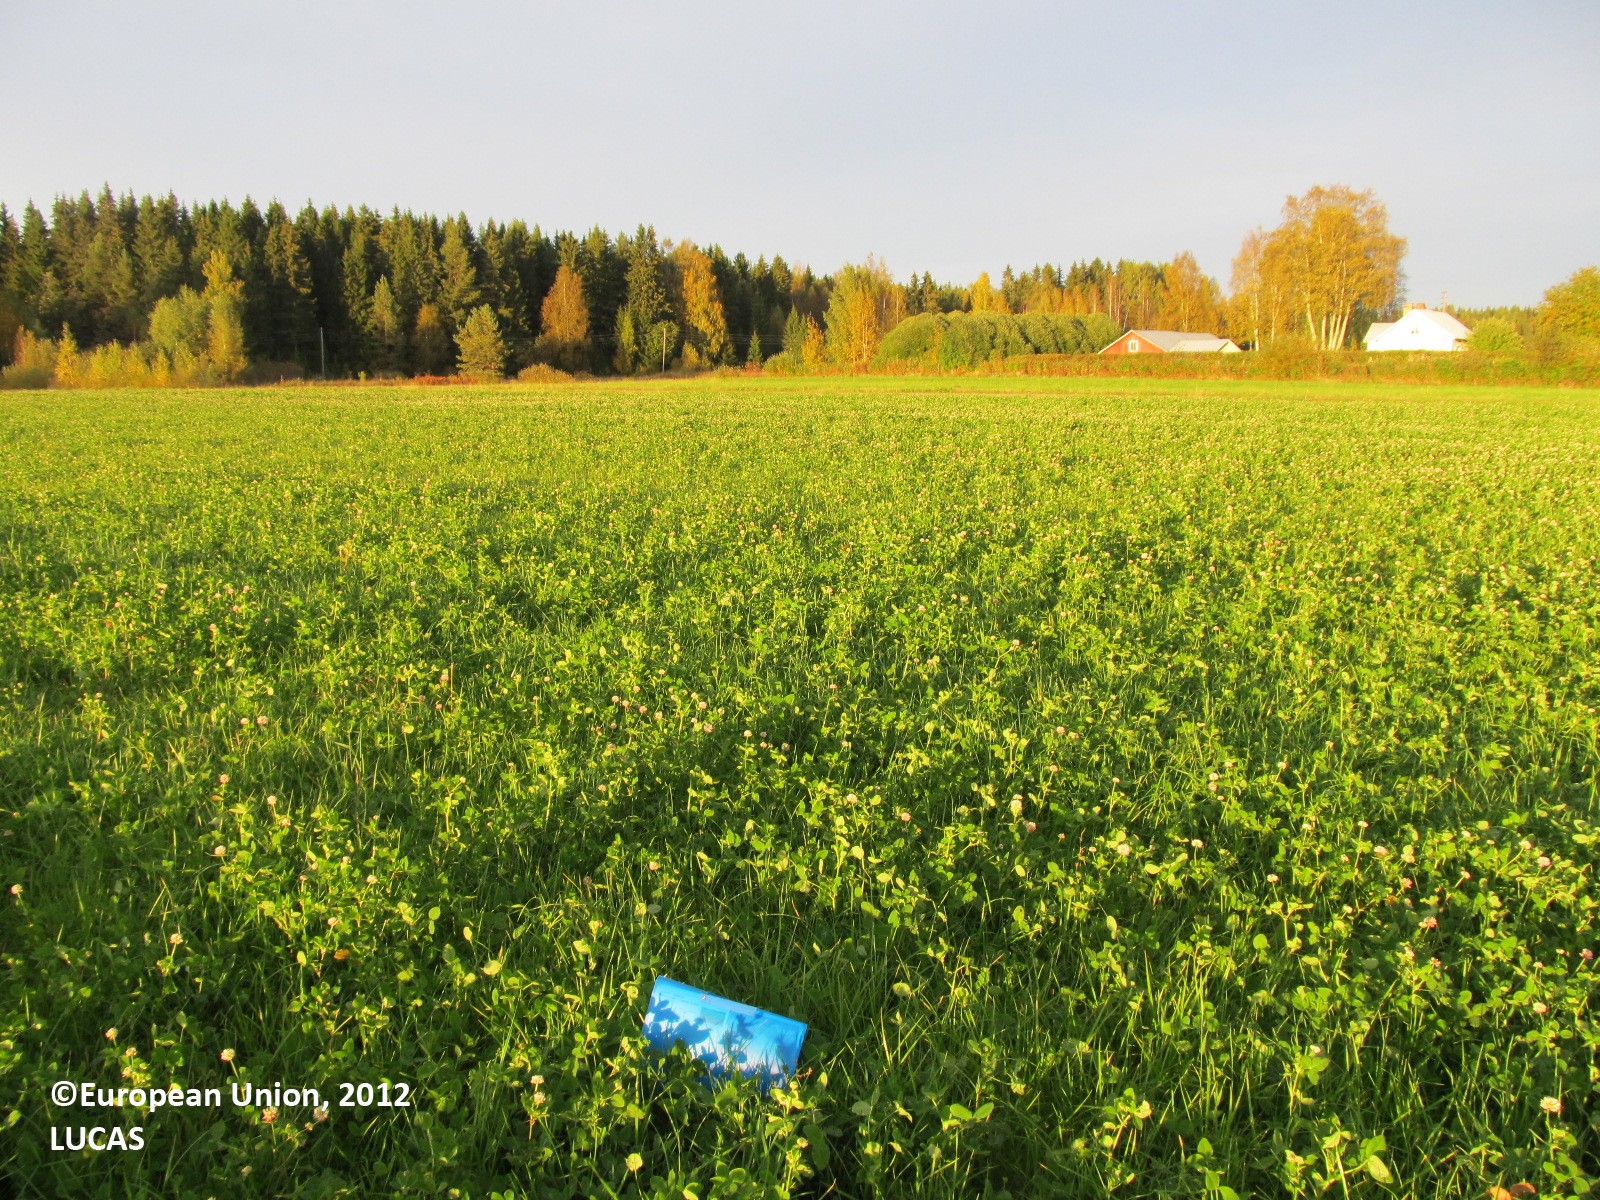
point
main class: Cropland
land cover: Clovers
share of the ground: > 75 %
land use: Agriculture (excluding fallow land and kitchen gardens)
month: September
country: FI
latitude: 62.7021
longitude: 28.3102
